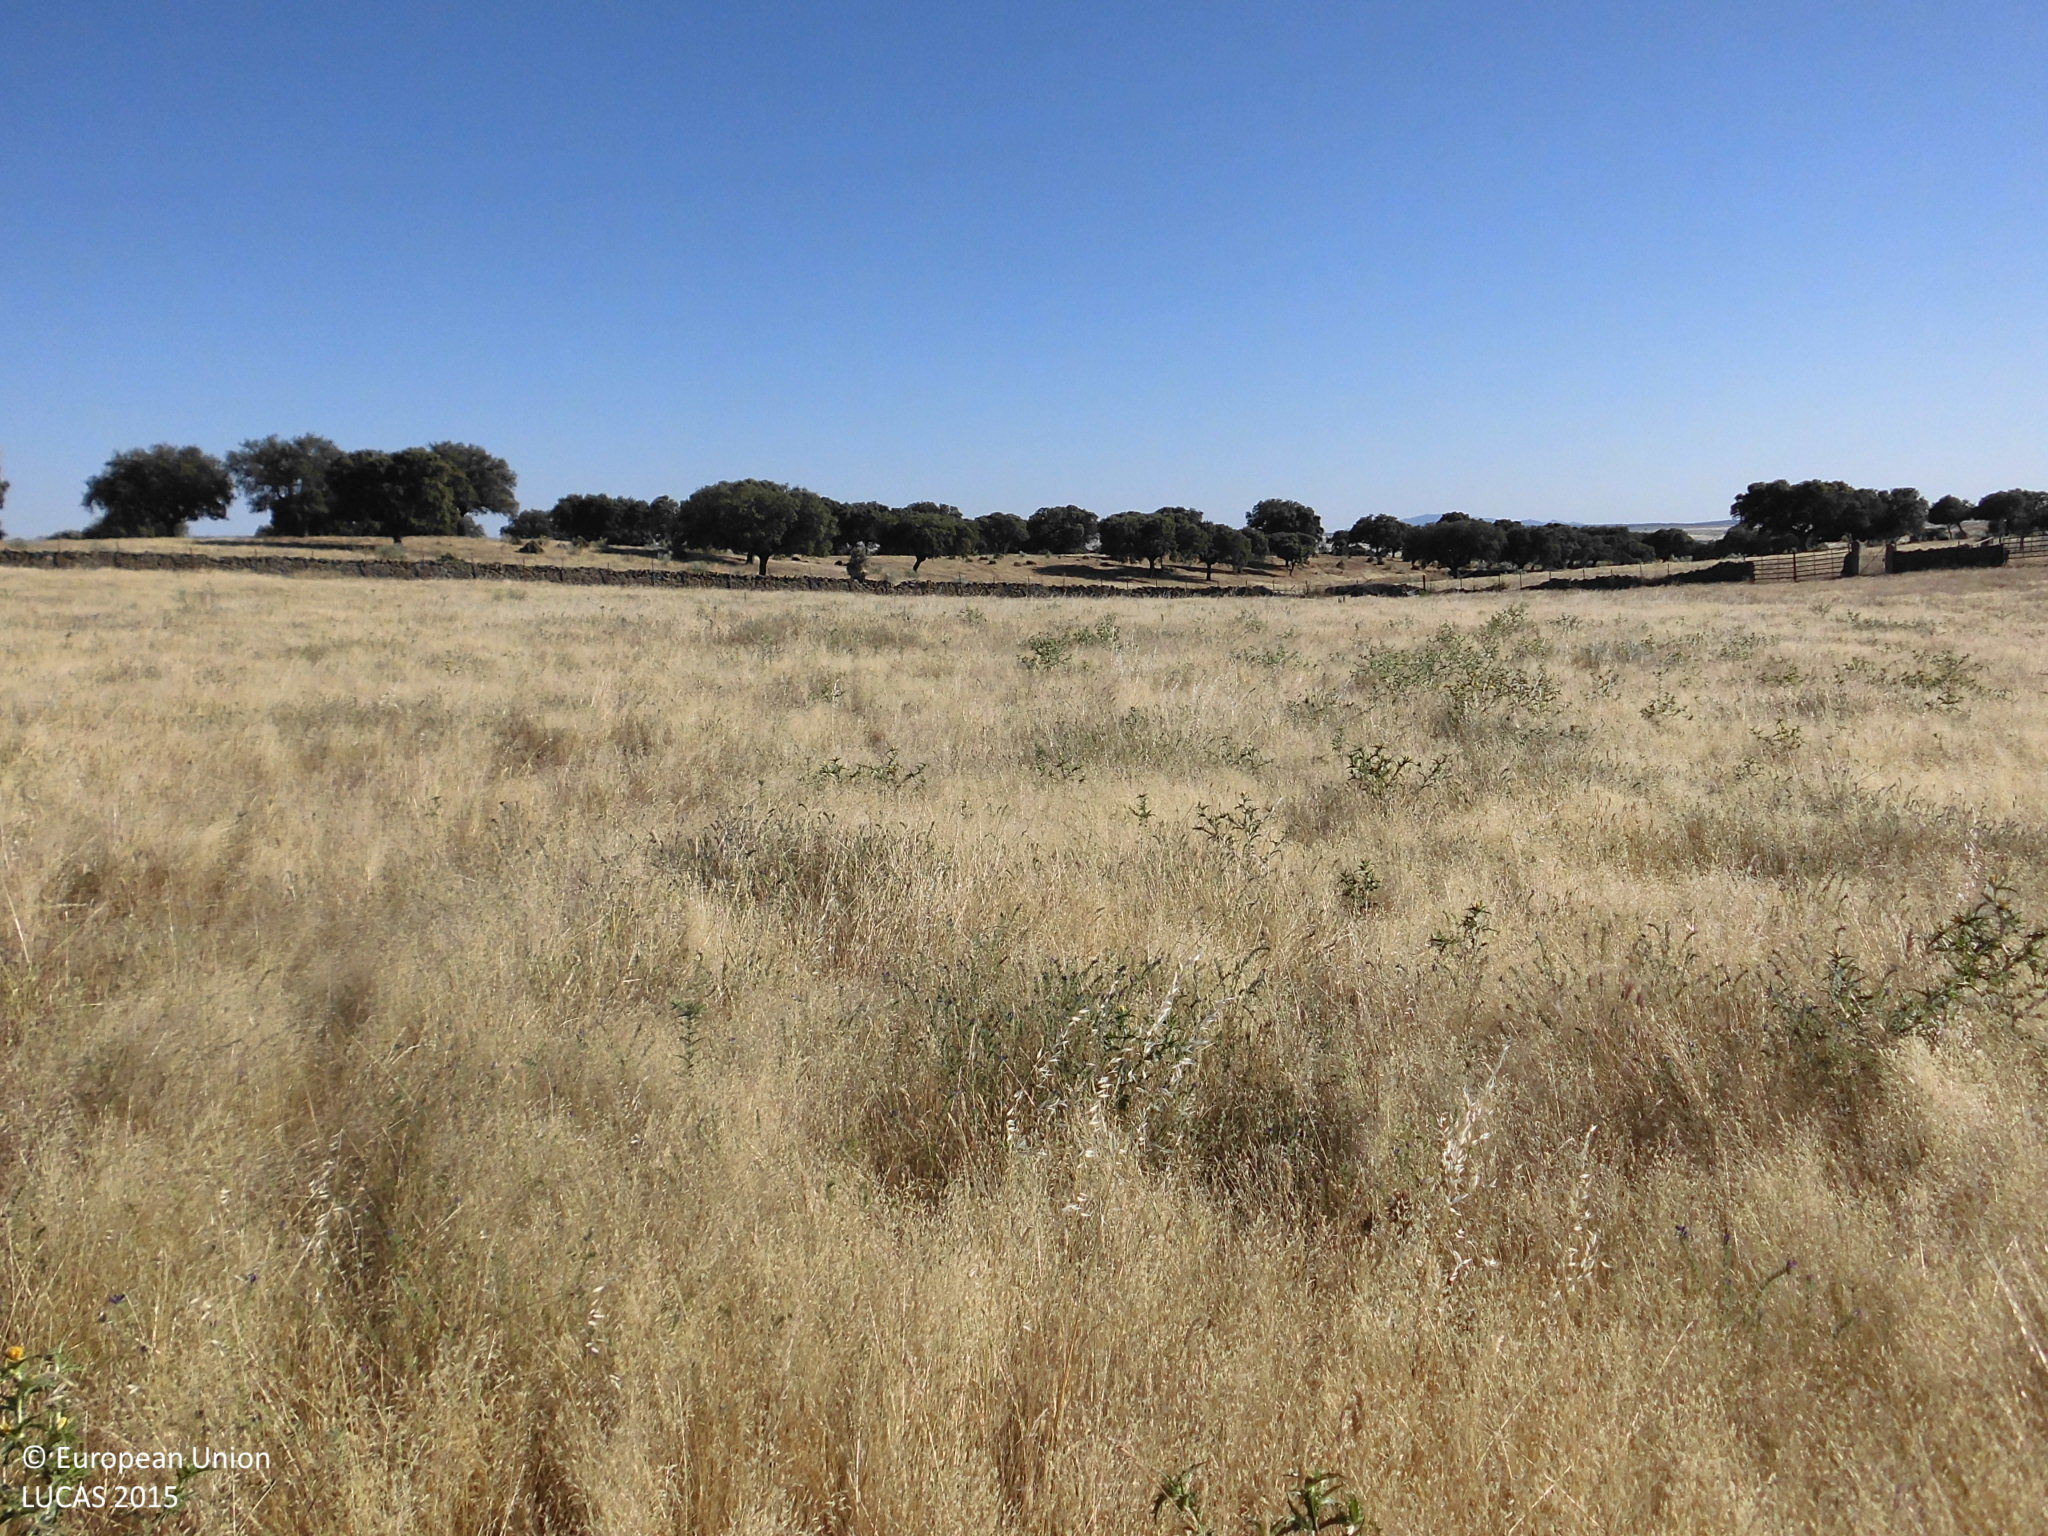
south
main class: Grassland
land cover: Grassland without tree/shrub cover
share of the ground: > 75 %
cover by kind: herbaceous plants 100 %
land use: Agriculture (excluding fallow land and kitchen gardens)
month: May
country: ES
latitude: 39.5466
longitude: -5.9212
